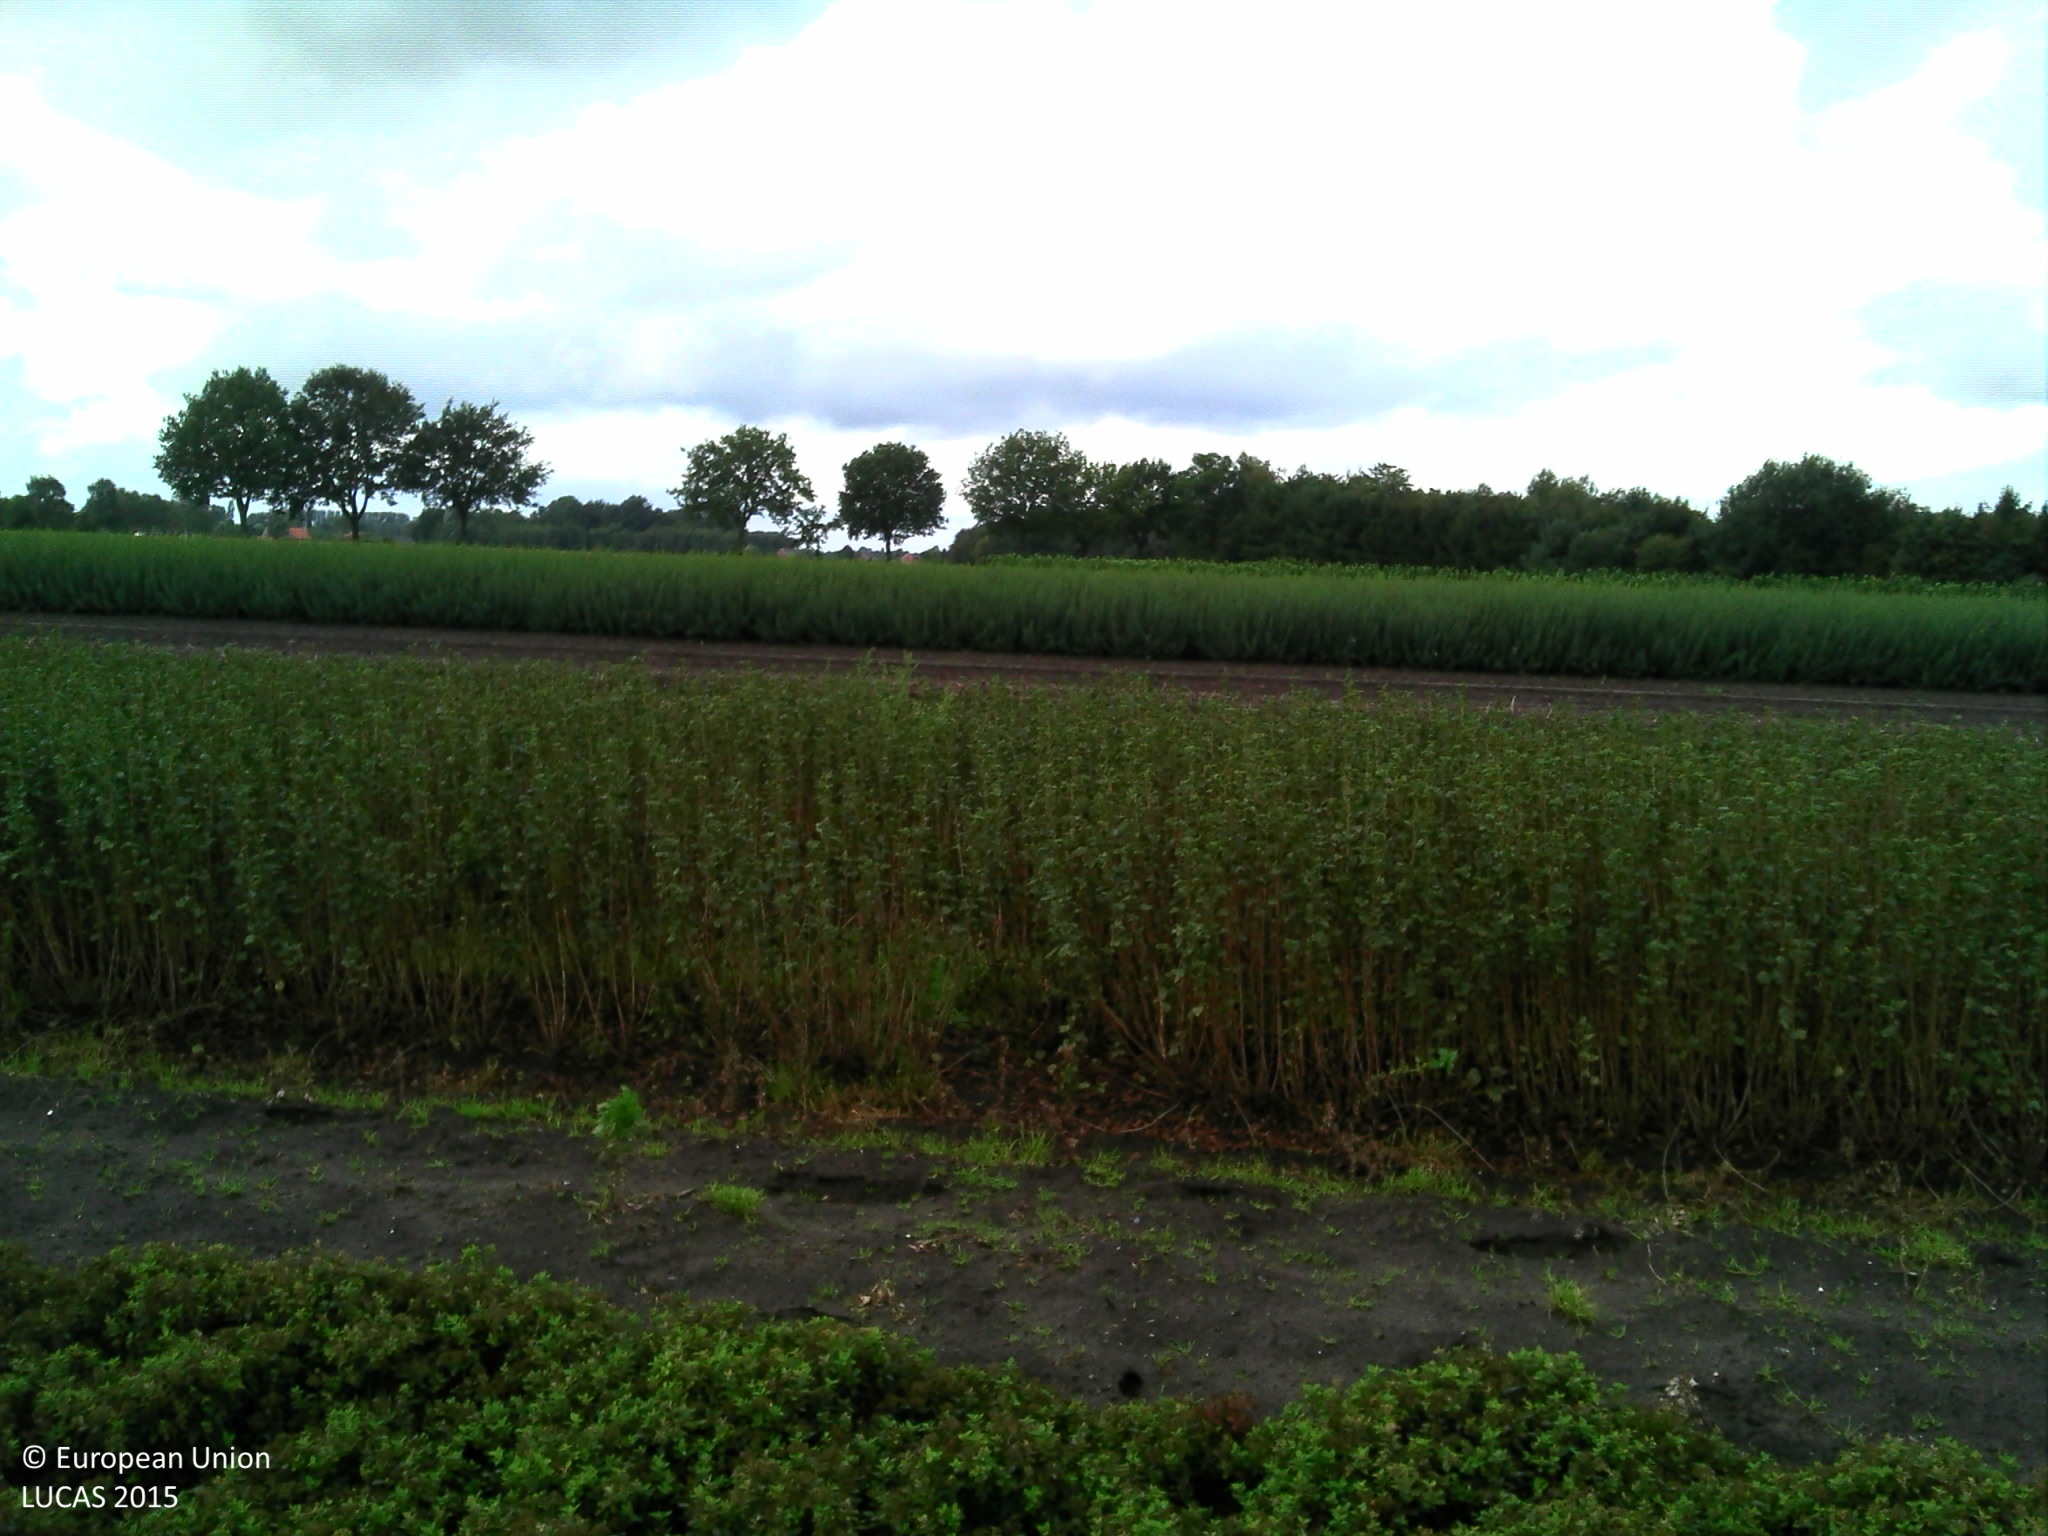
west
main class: Cropland
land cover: Nurseries
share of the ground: 50 - 75 %
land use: Agriculture (excluding fallow land and kitchen gardens)
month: September
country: BE
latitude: 51.4517
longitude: 4.7729
